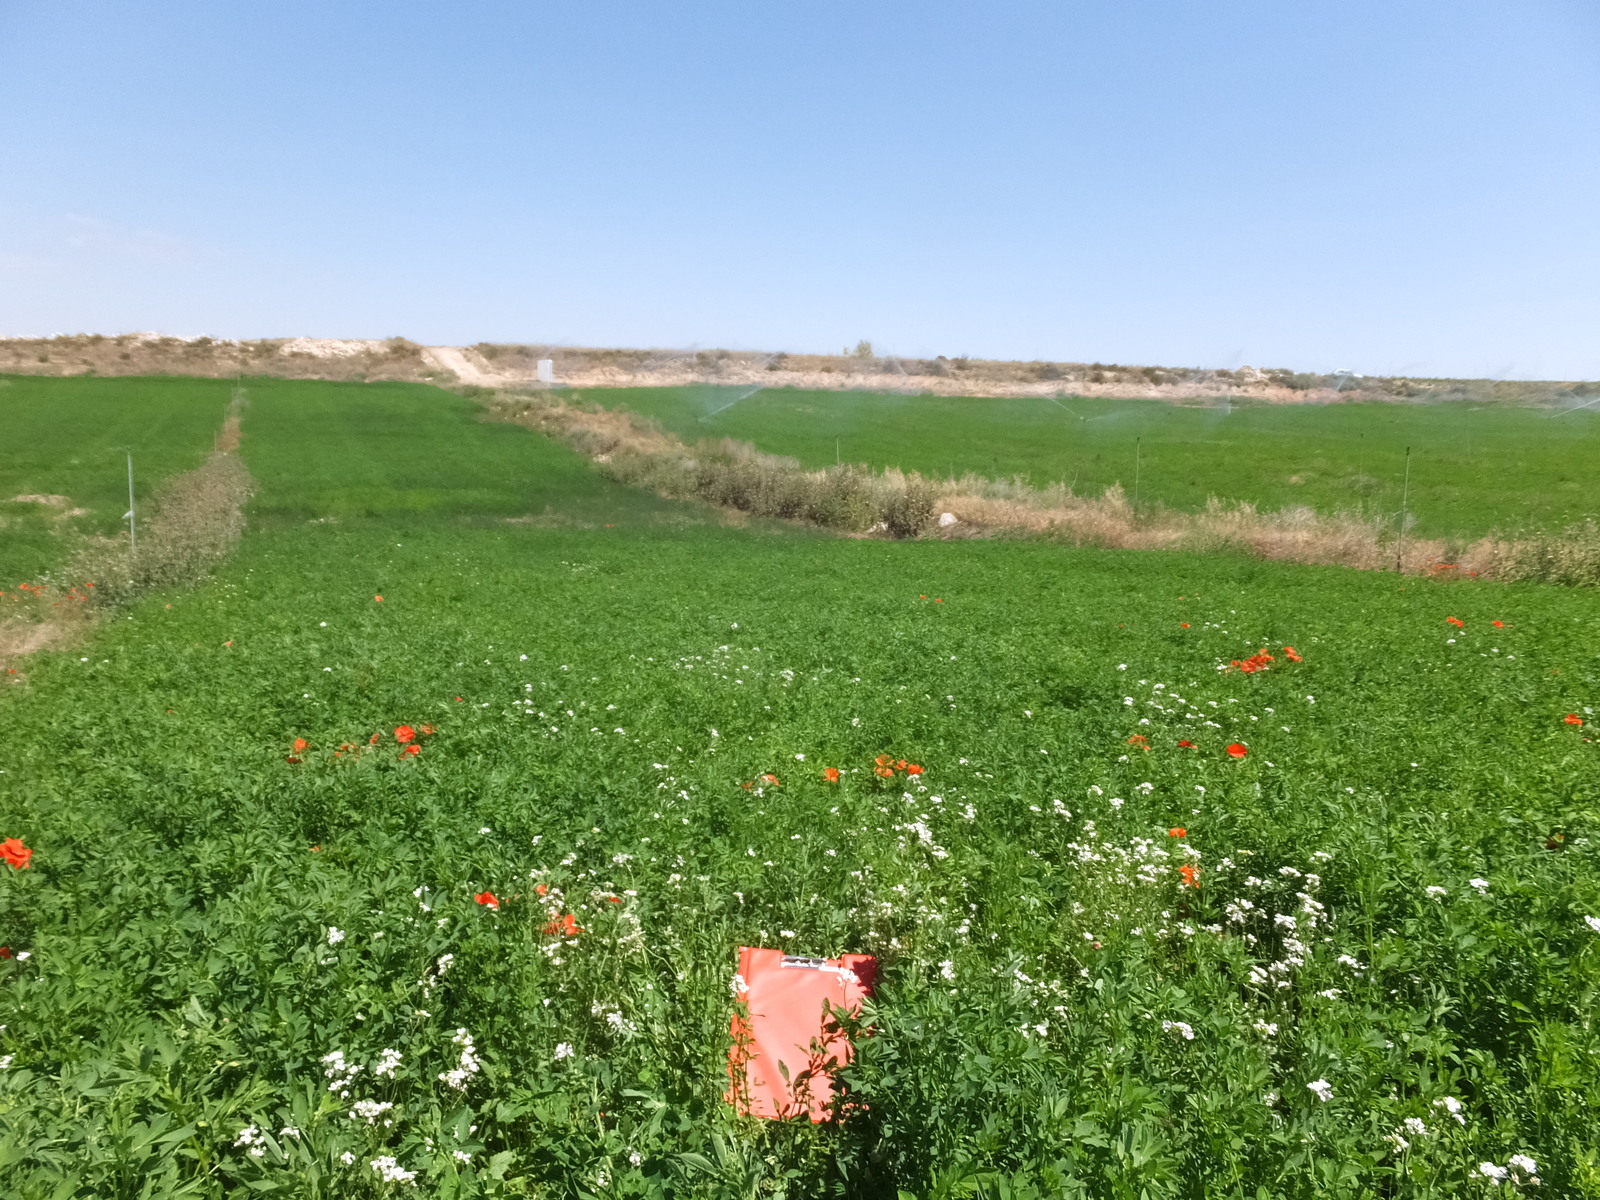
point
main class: Cropland
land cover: Lucerne
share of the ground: > 75 %
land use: Agriculture (excluding fallow land and kitchen gardens)
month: June
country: ES
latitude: 41.4727
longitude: 0.0592
